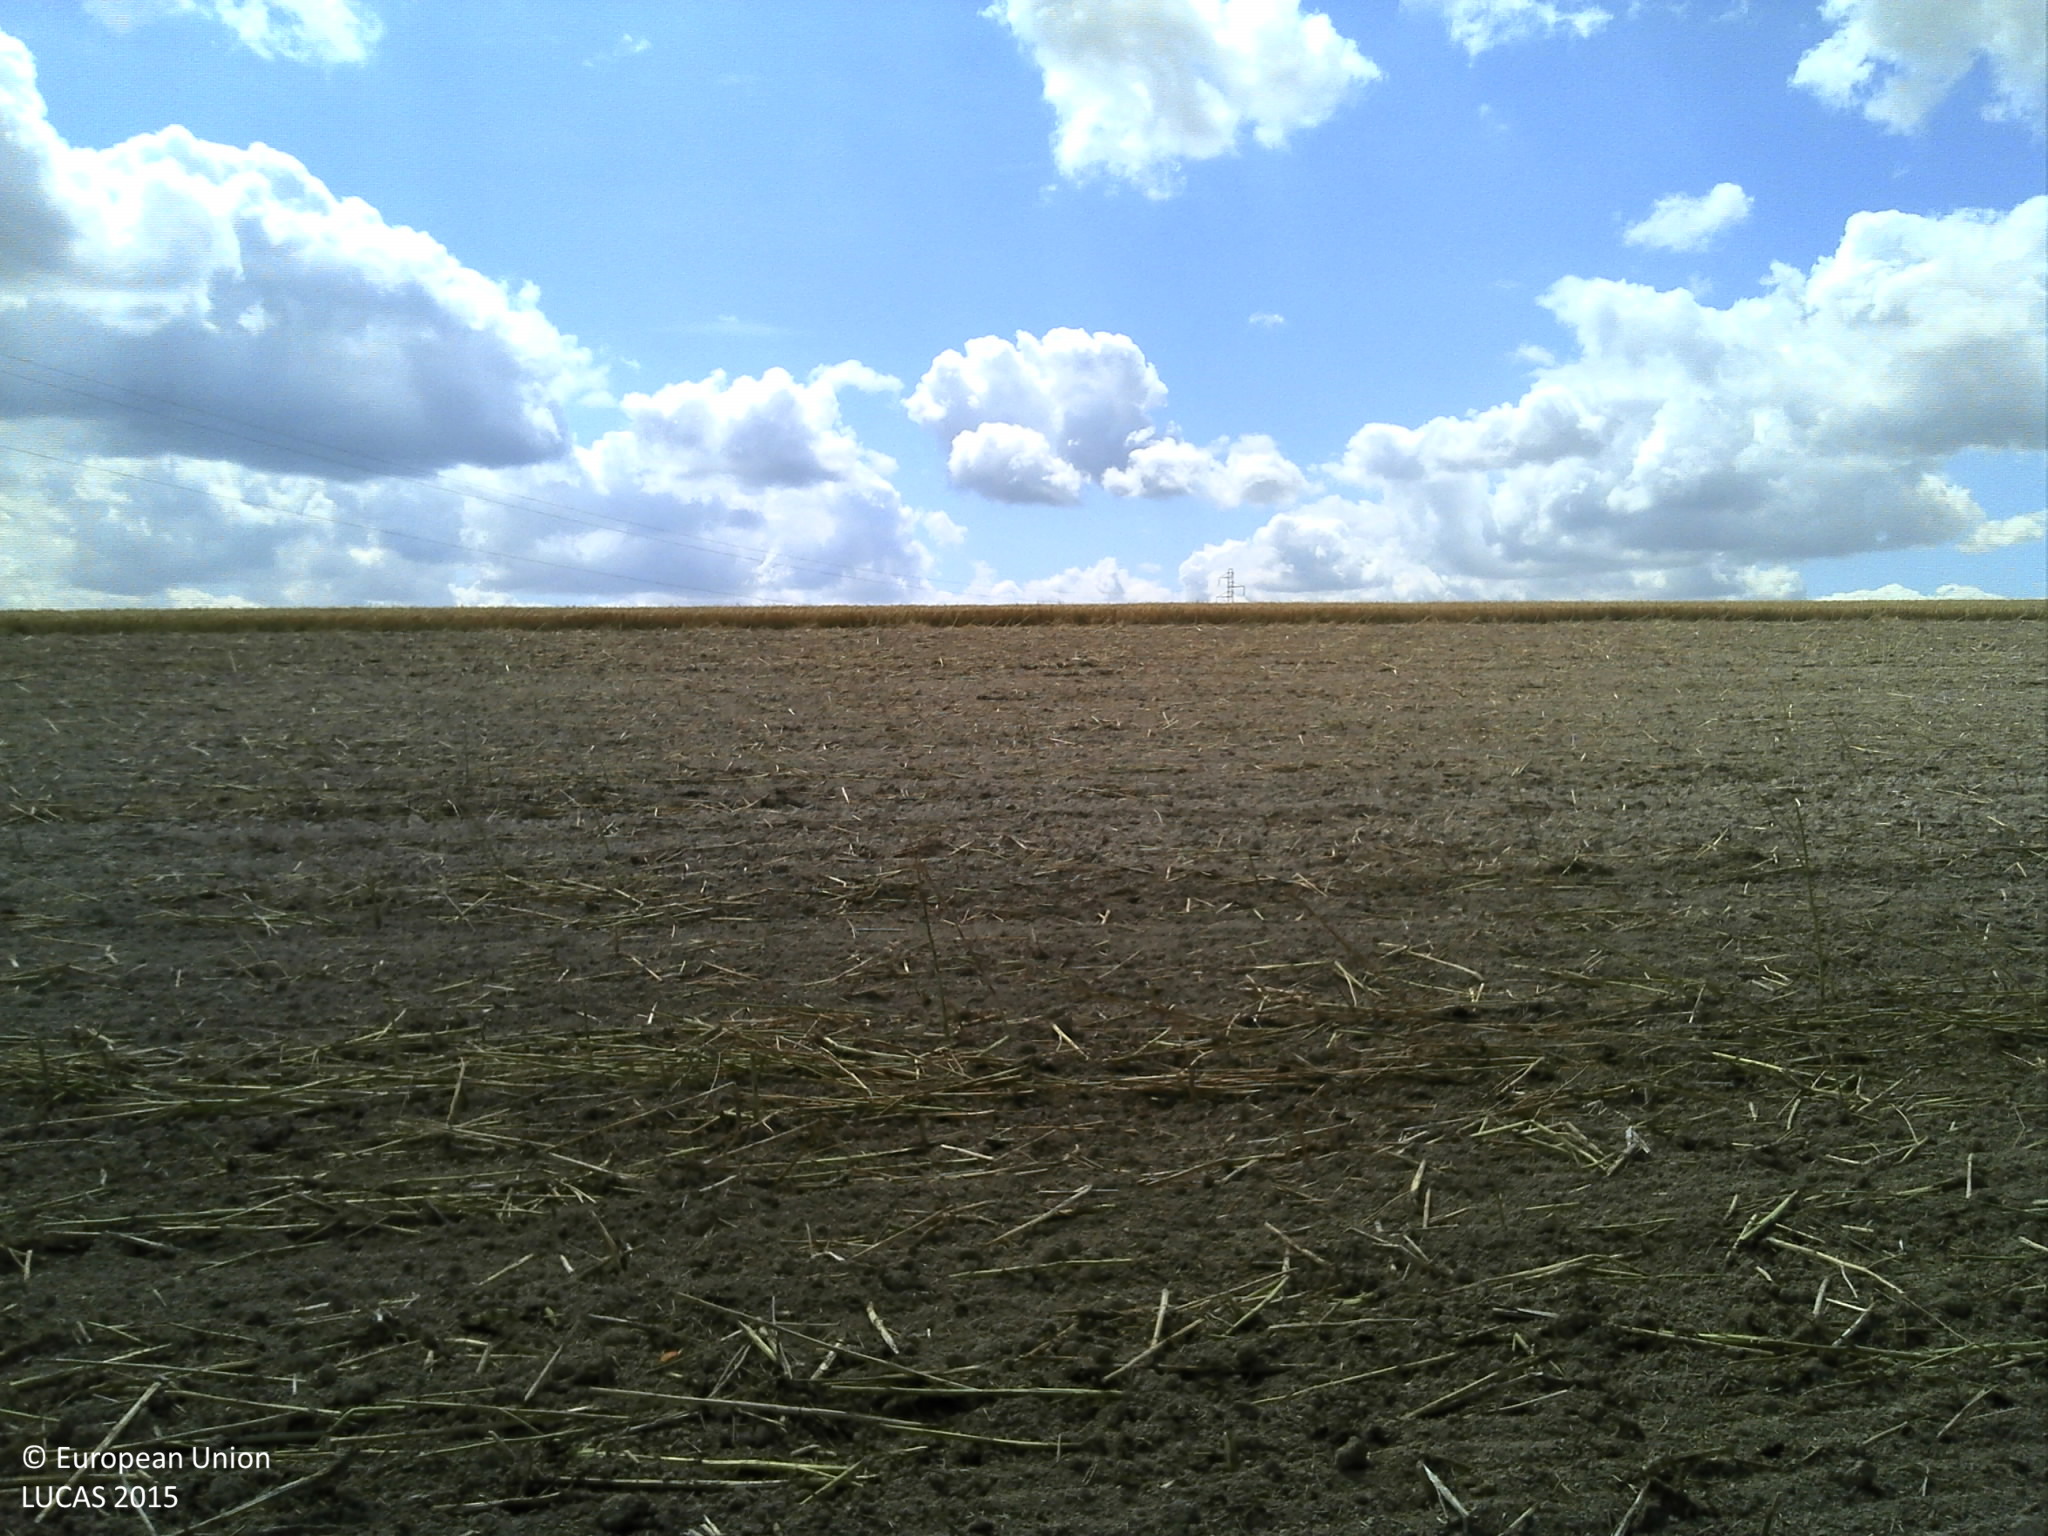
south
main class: Woodland
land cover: Pine dominated mixed woodland
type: alpine coniferous forest
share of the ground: > 75 %
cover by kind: coniferous forest trees 40 %, herbaceous plants 40 %, broadleaved forest trees 20 %
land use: Forestry
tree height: > 5 m
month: July
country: FR
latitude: 49.3195
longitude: 4.6452
